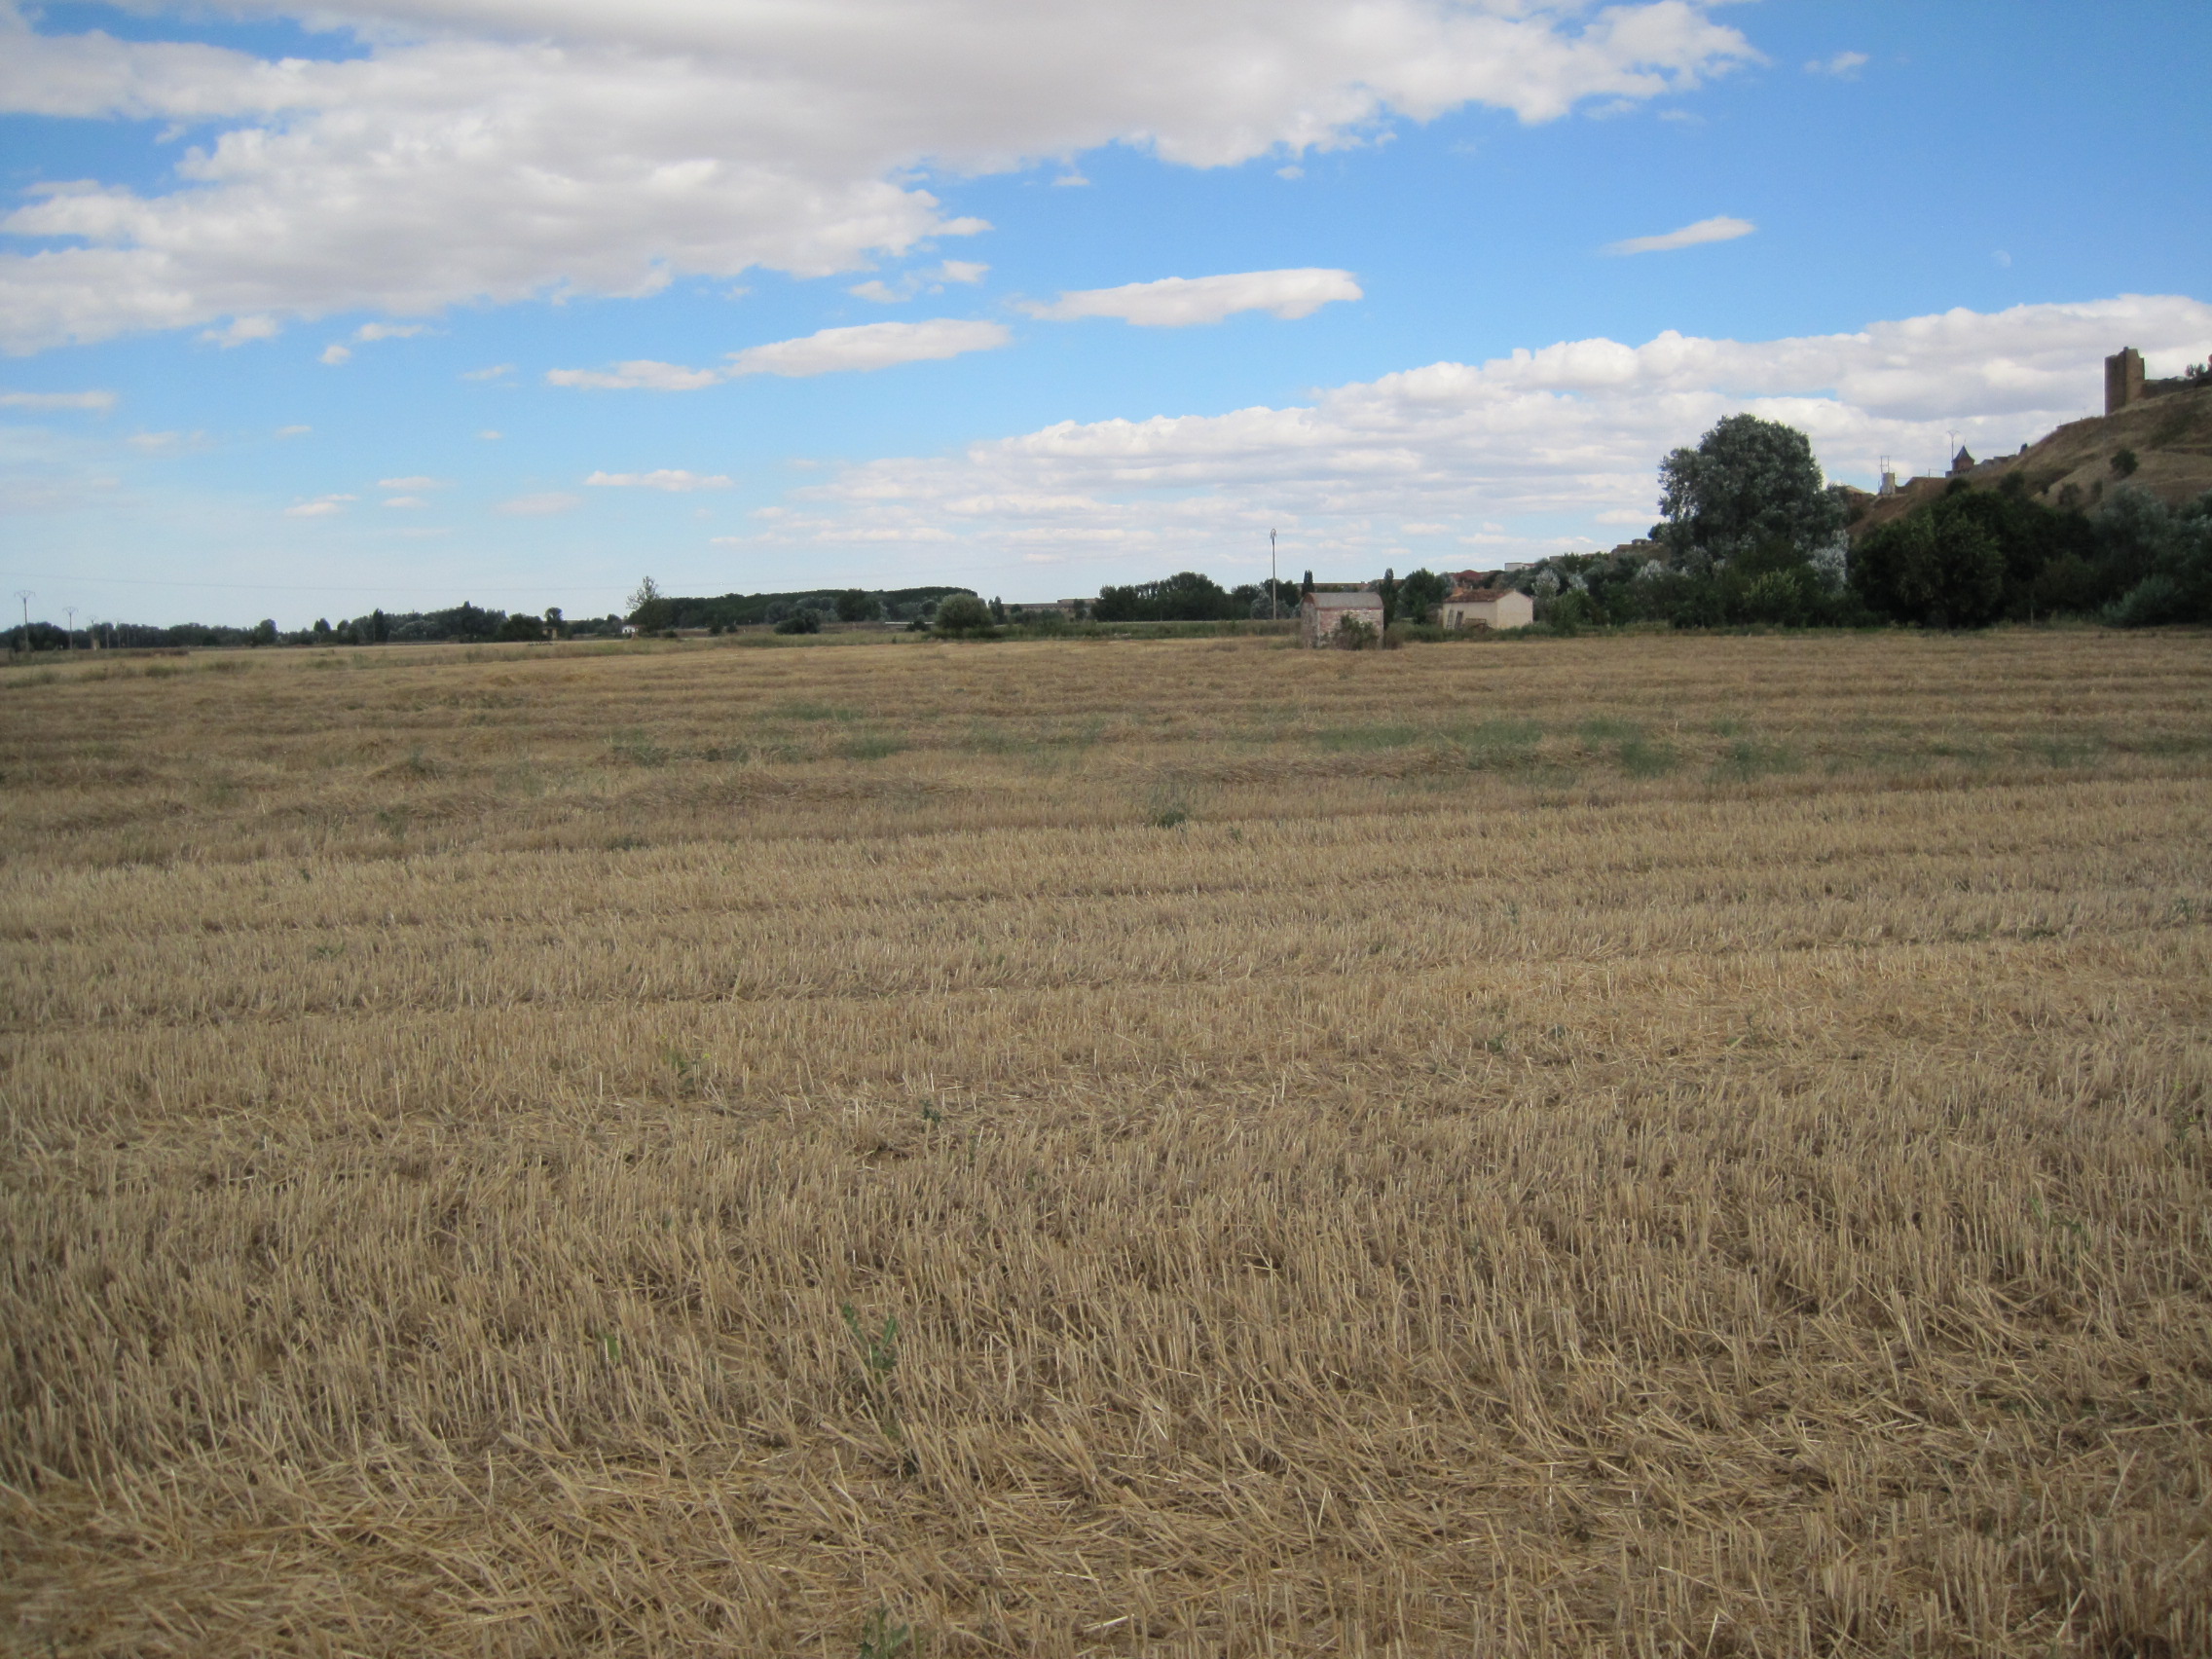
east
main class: Cropland
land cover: Common wheat
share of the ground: < 10 %
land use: Agriculture (excluding fallow land and kitchen gardens)
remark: Harvested field
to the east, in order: Common wheat; Grass margins; Common wheat; Grass margins; Barley; Tracks; Barley; Grass margins; Tracks
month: July
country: ES
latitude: 42.0838
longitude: -5.4530
